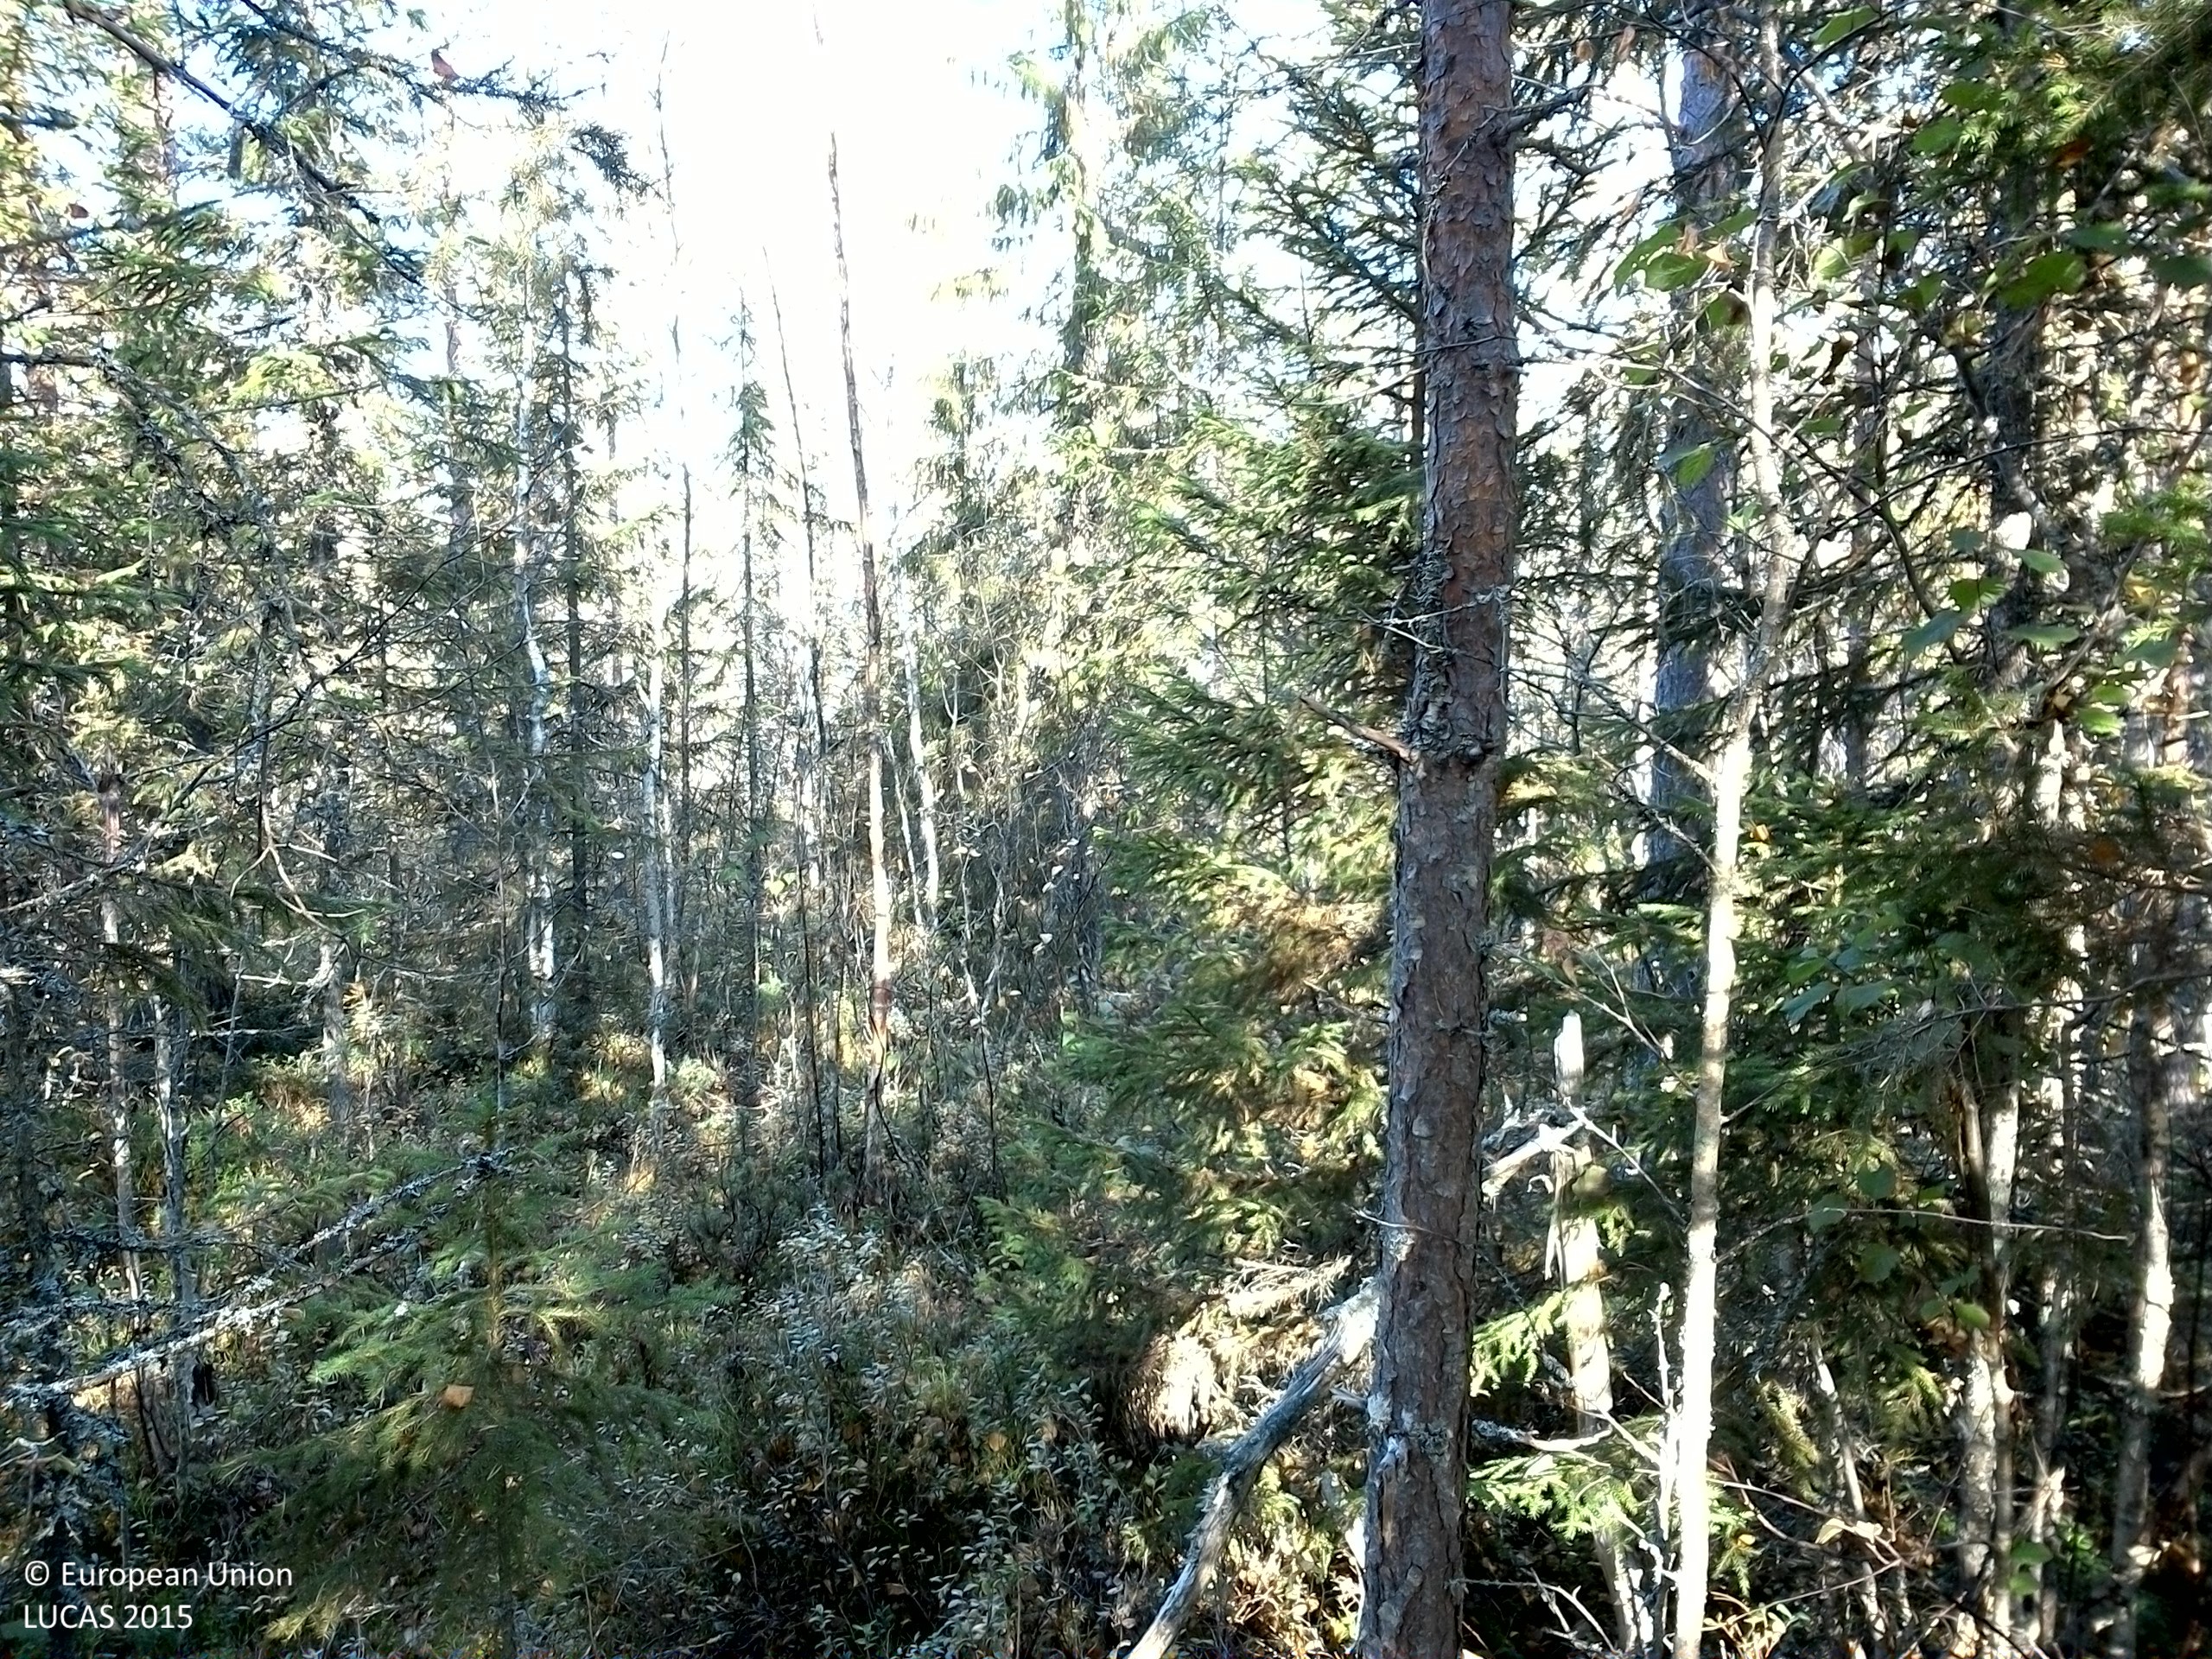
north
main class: Woodland
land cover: Other mixed woodland
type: boreal forest
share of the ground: 50 - 75 %
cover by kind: coniferous forest trees 50 %, broadleaved forest trees 20 %, shrubs 20 %, lichens and mosses 10 %
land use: Forestry
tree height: > 5 m
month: October
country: SE
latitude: 61.3728
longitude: 15.0179
